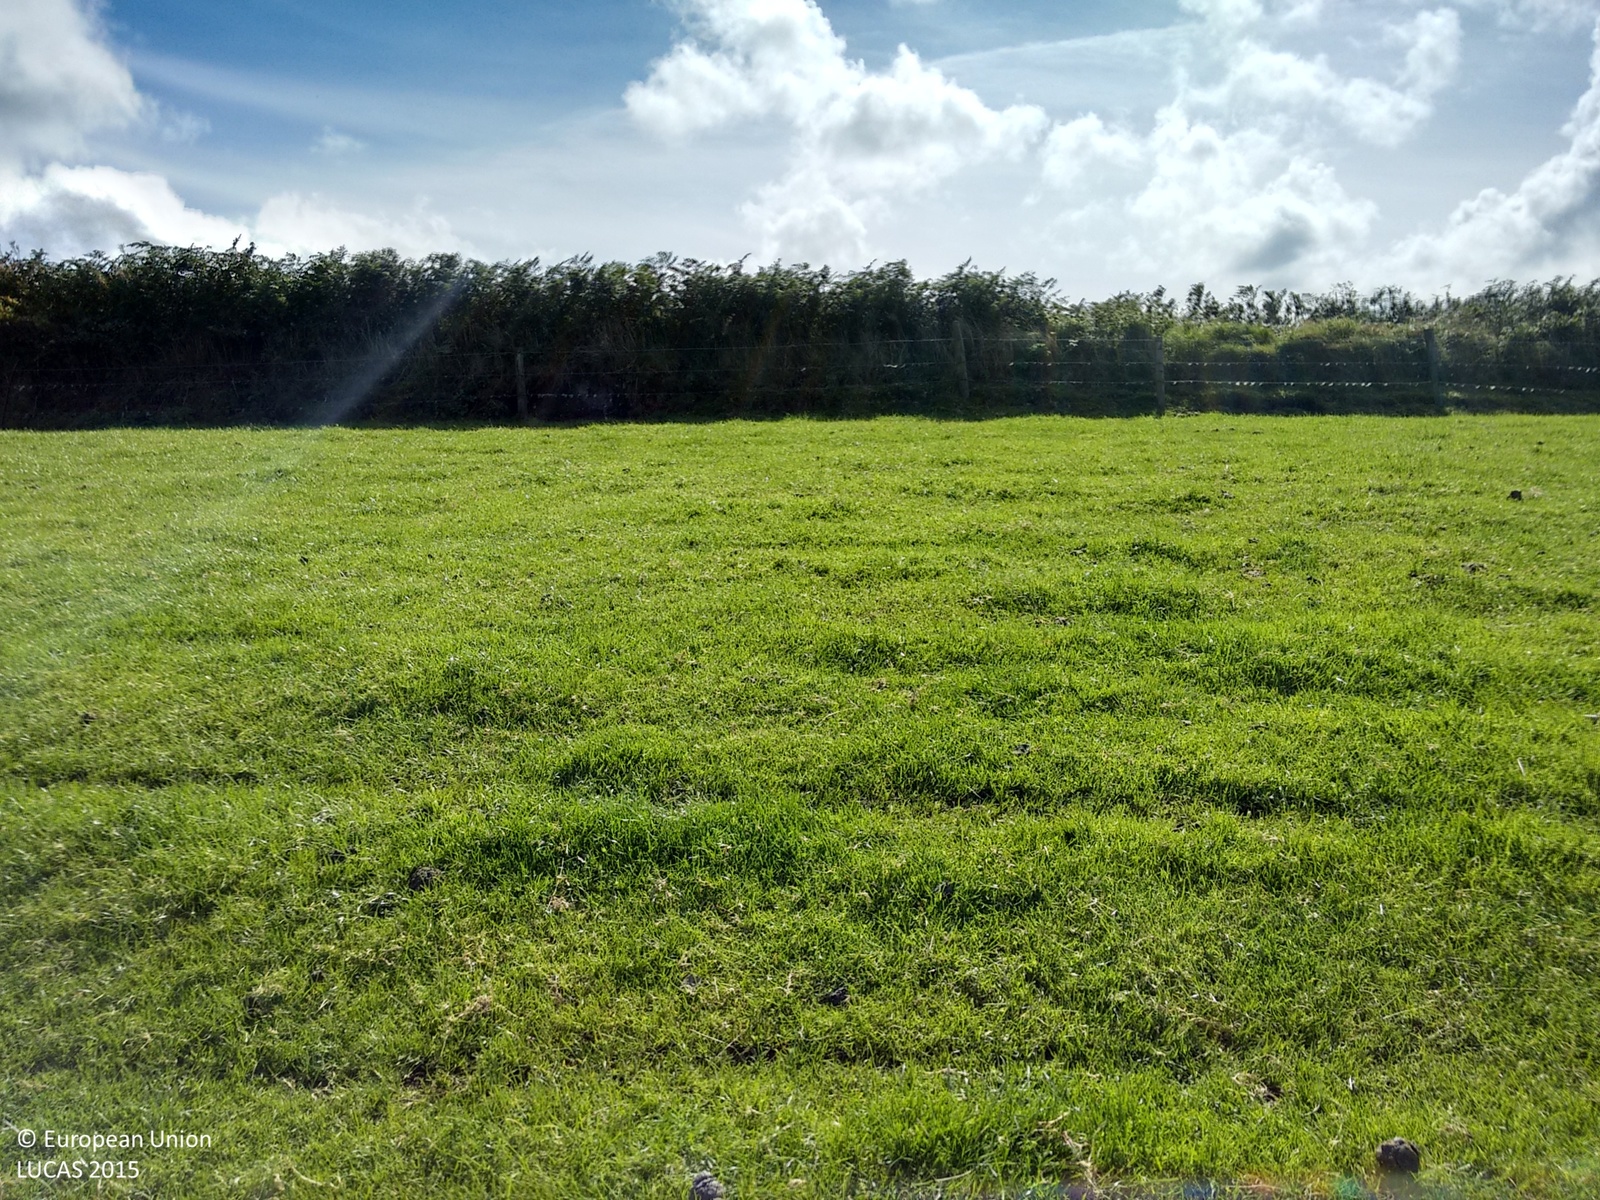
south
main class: Grassland
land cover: Grassland without tree/shrub cover
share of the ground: > 75 %
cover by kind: herbaceous plants 100 %
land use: Agriculture (excluding fallow land and kitchen gardens)
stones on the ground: < 10 %
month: September
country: GB
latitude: 50.6452
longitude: -4.4577
